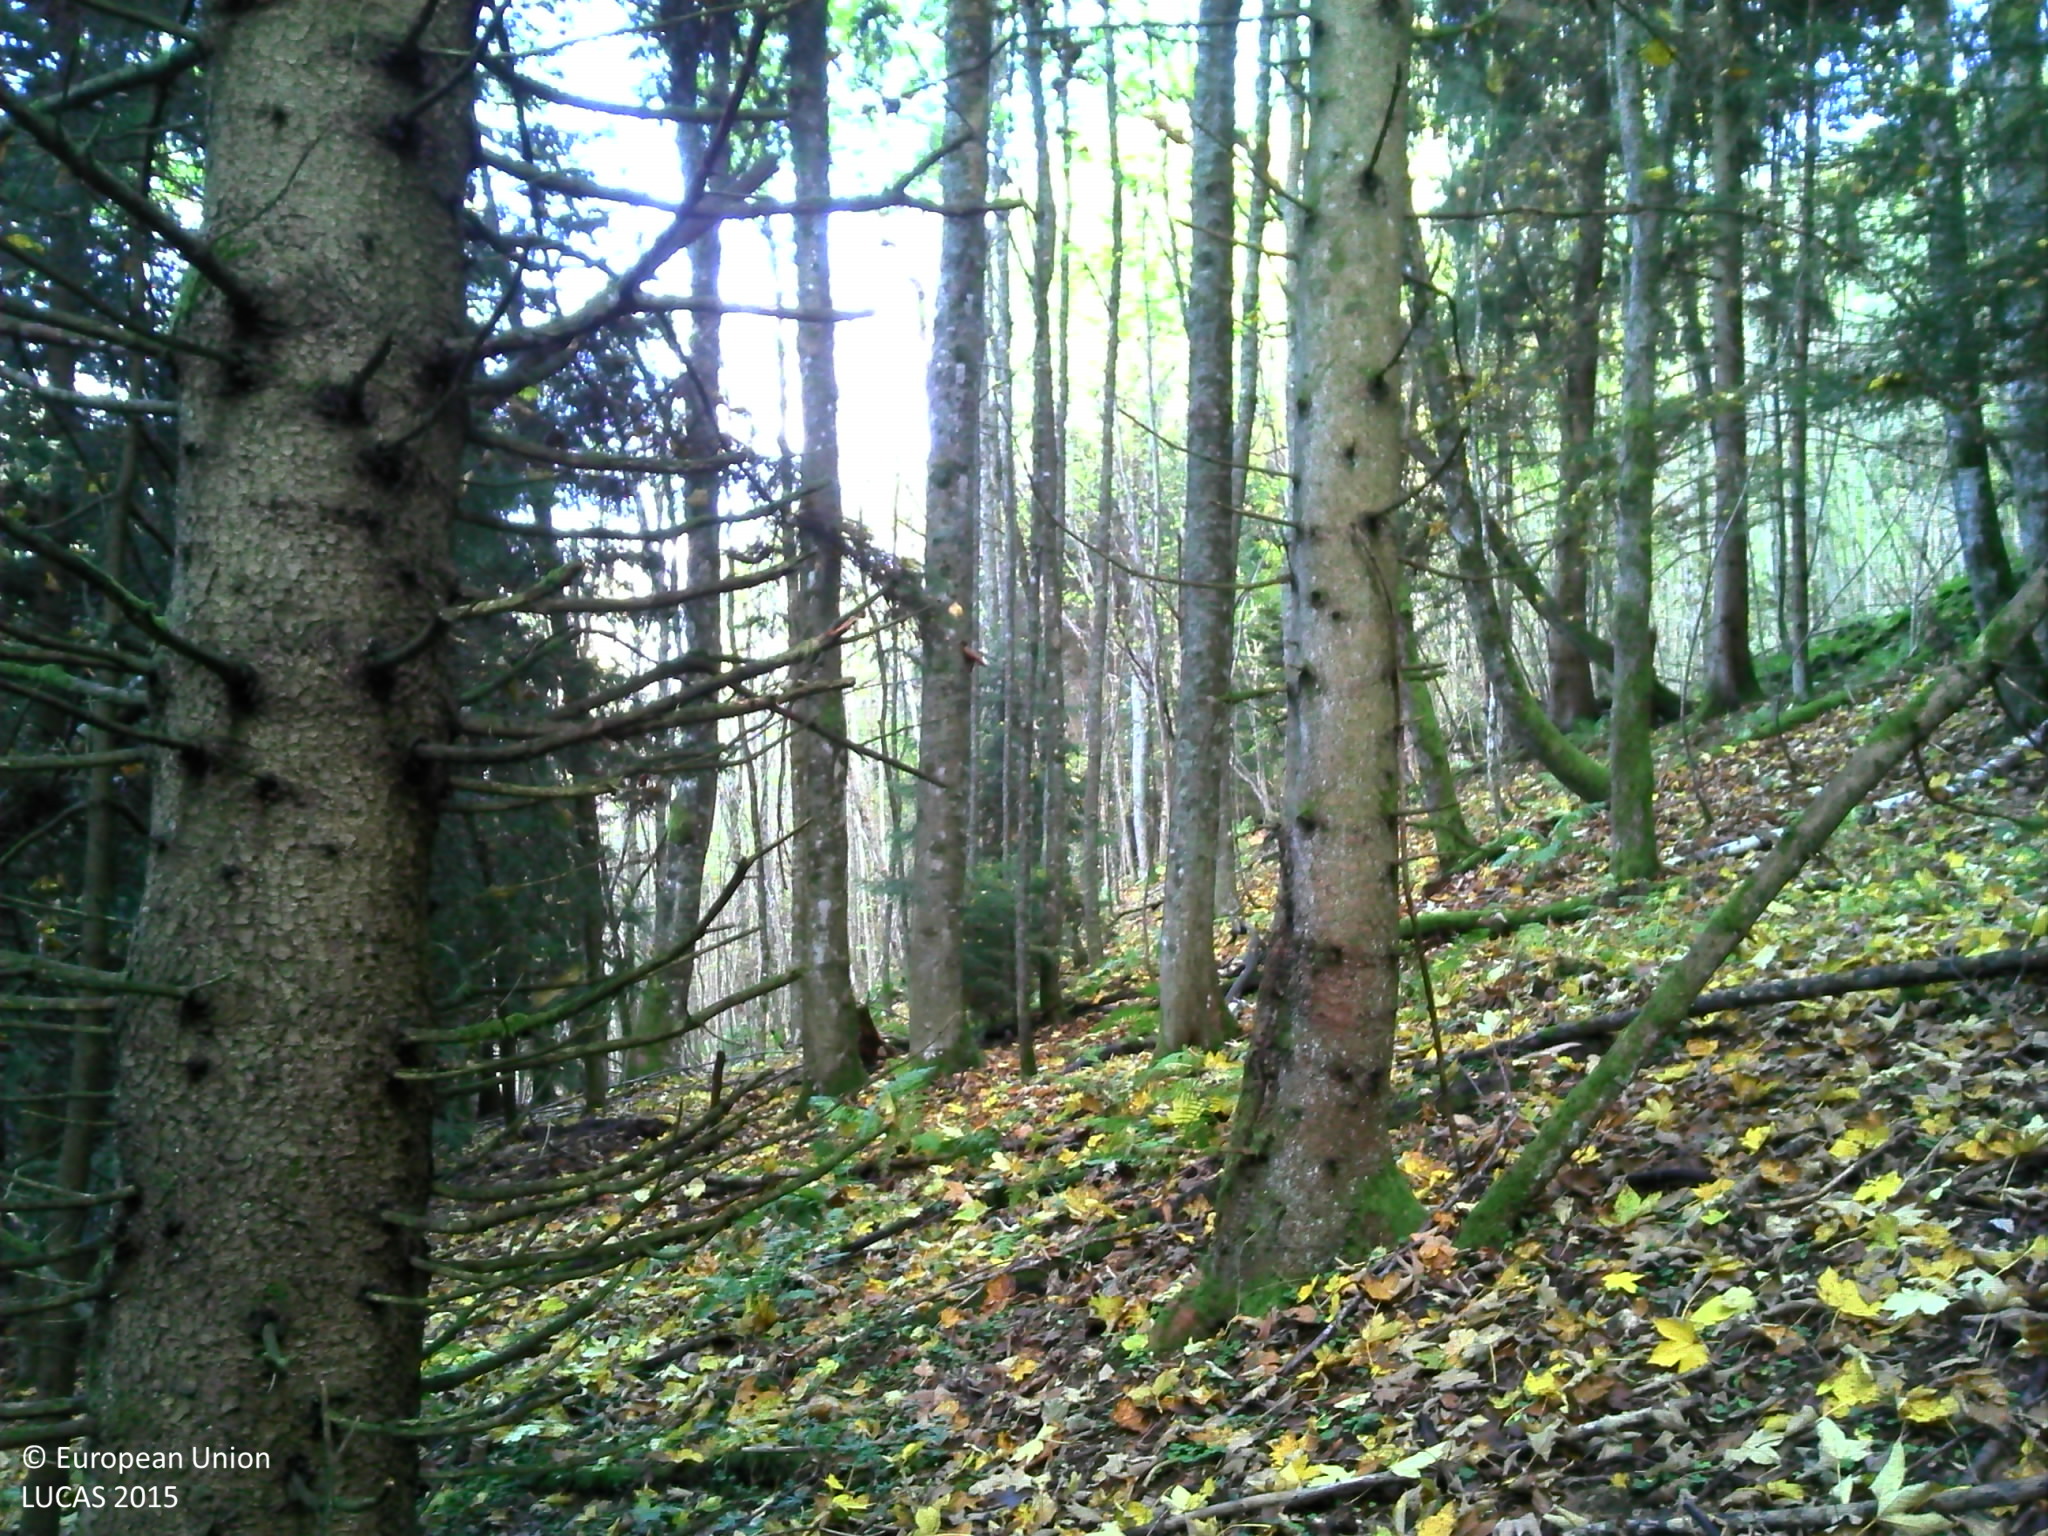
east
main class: Woodland
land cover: Spruce dominated mixed woodland
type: hemiboreal forest and nemoral coniferous forest and mixed broadleaved-coniferous forest
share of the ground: > 75 %
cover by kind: coniferous forest trees 50 %, broadleaved forest trees 35 %, unconsolidated bare surface 15 %
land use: Forestry
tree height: > 5 m
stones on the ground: < 10 %
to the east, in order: Spruce dominated mixed woodland; Broadleaved woodland; Spruce dominated mixed woodland; Tracks; Shrubland with sparse tree cover; Spruce dominated mixed woodland; Rivers and streams; Spruce dominated mixed woodland
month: October
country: FR
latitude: 45.4562
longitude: 6.2579
